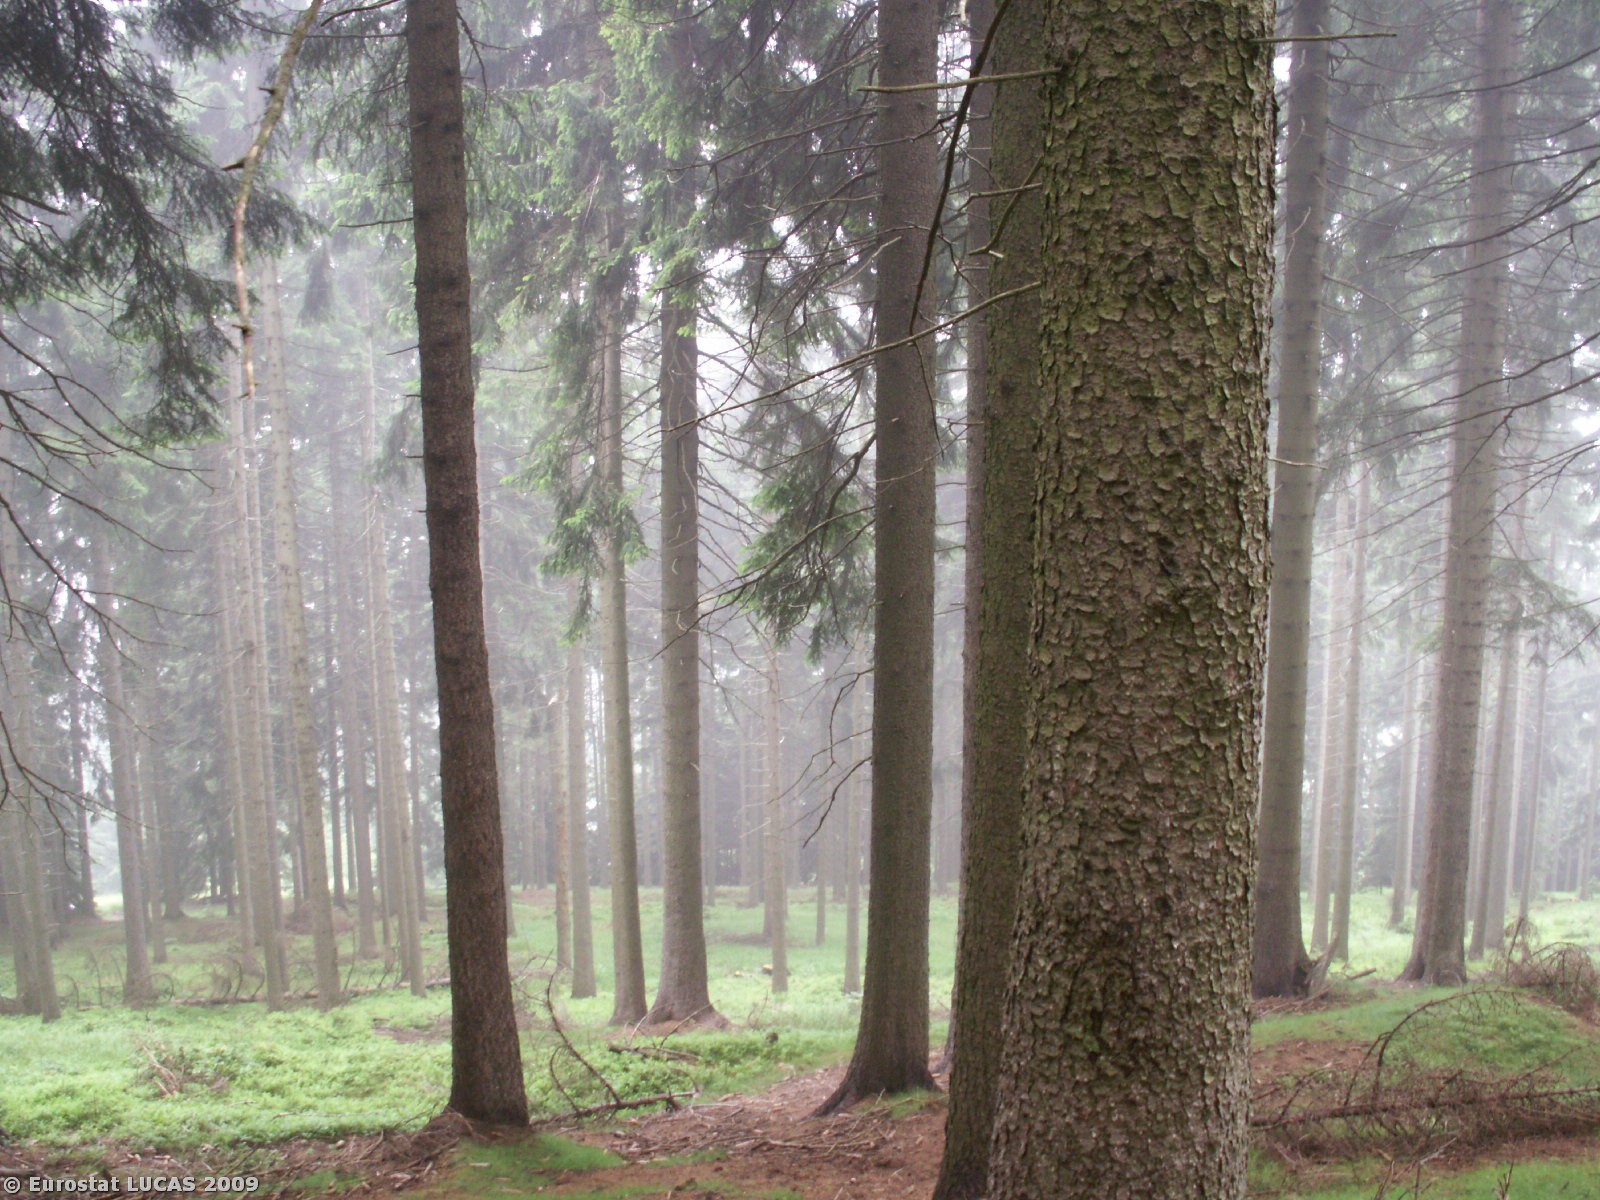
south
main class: Woodland
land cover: Coniferous woodland
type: hemiboreal forest and nemoral coniferous forest and mixed broadleaved-coniferous forest
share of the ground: > 75 %
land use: Forestry
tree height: > 5 m
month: June
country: CZ
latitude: 50.3672
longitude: 12.7413
